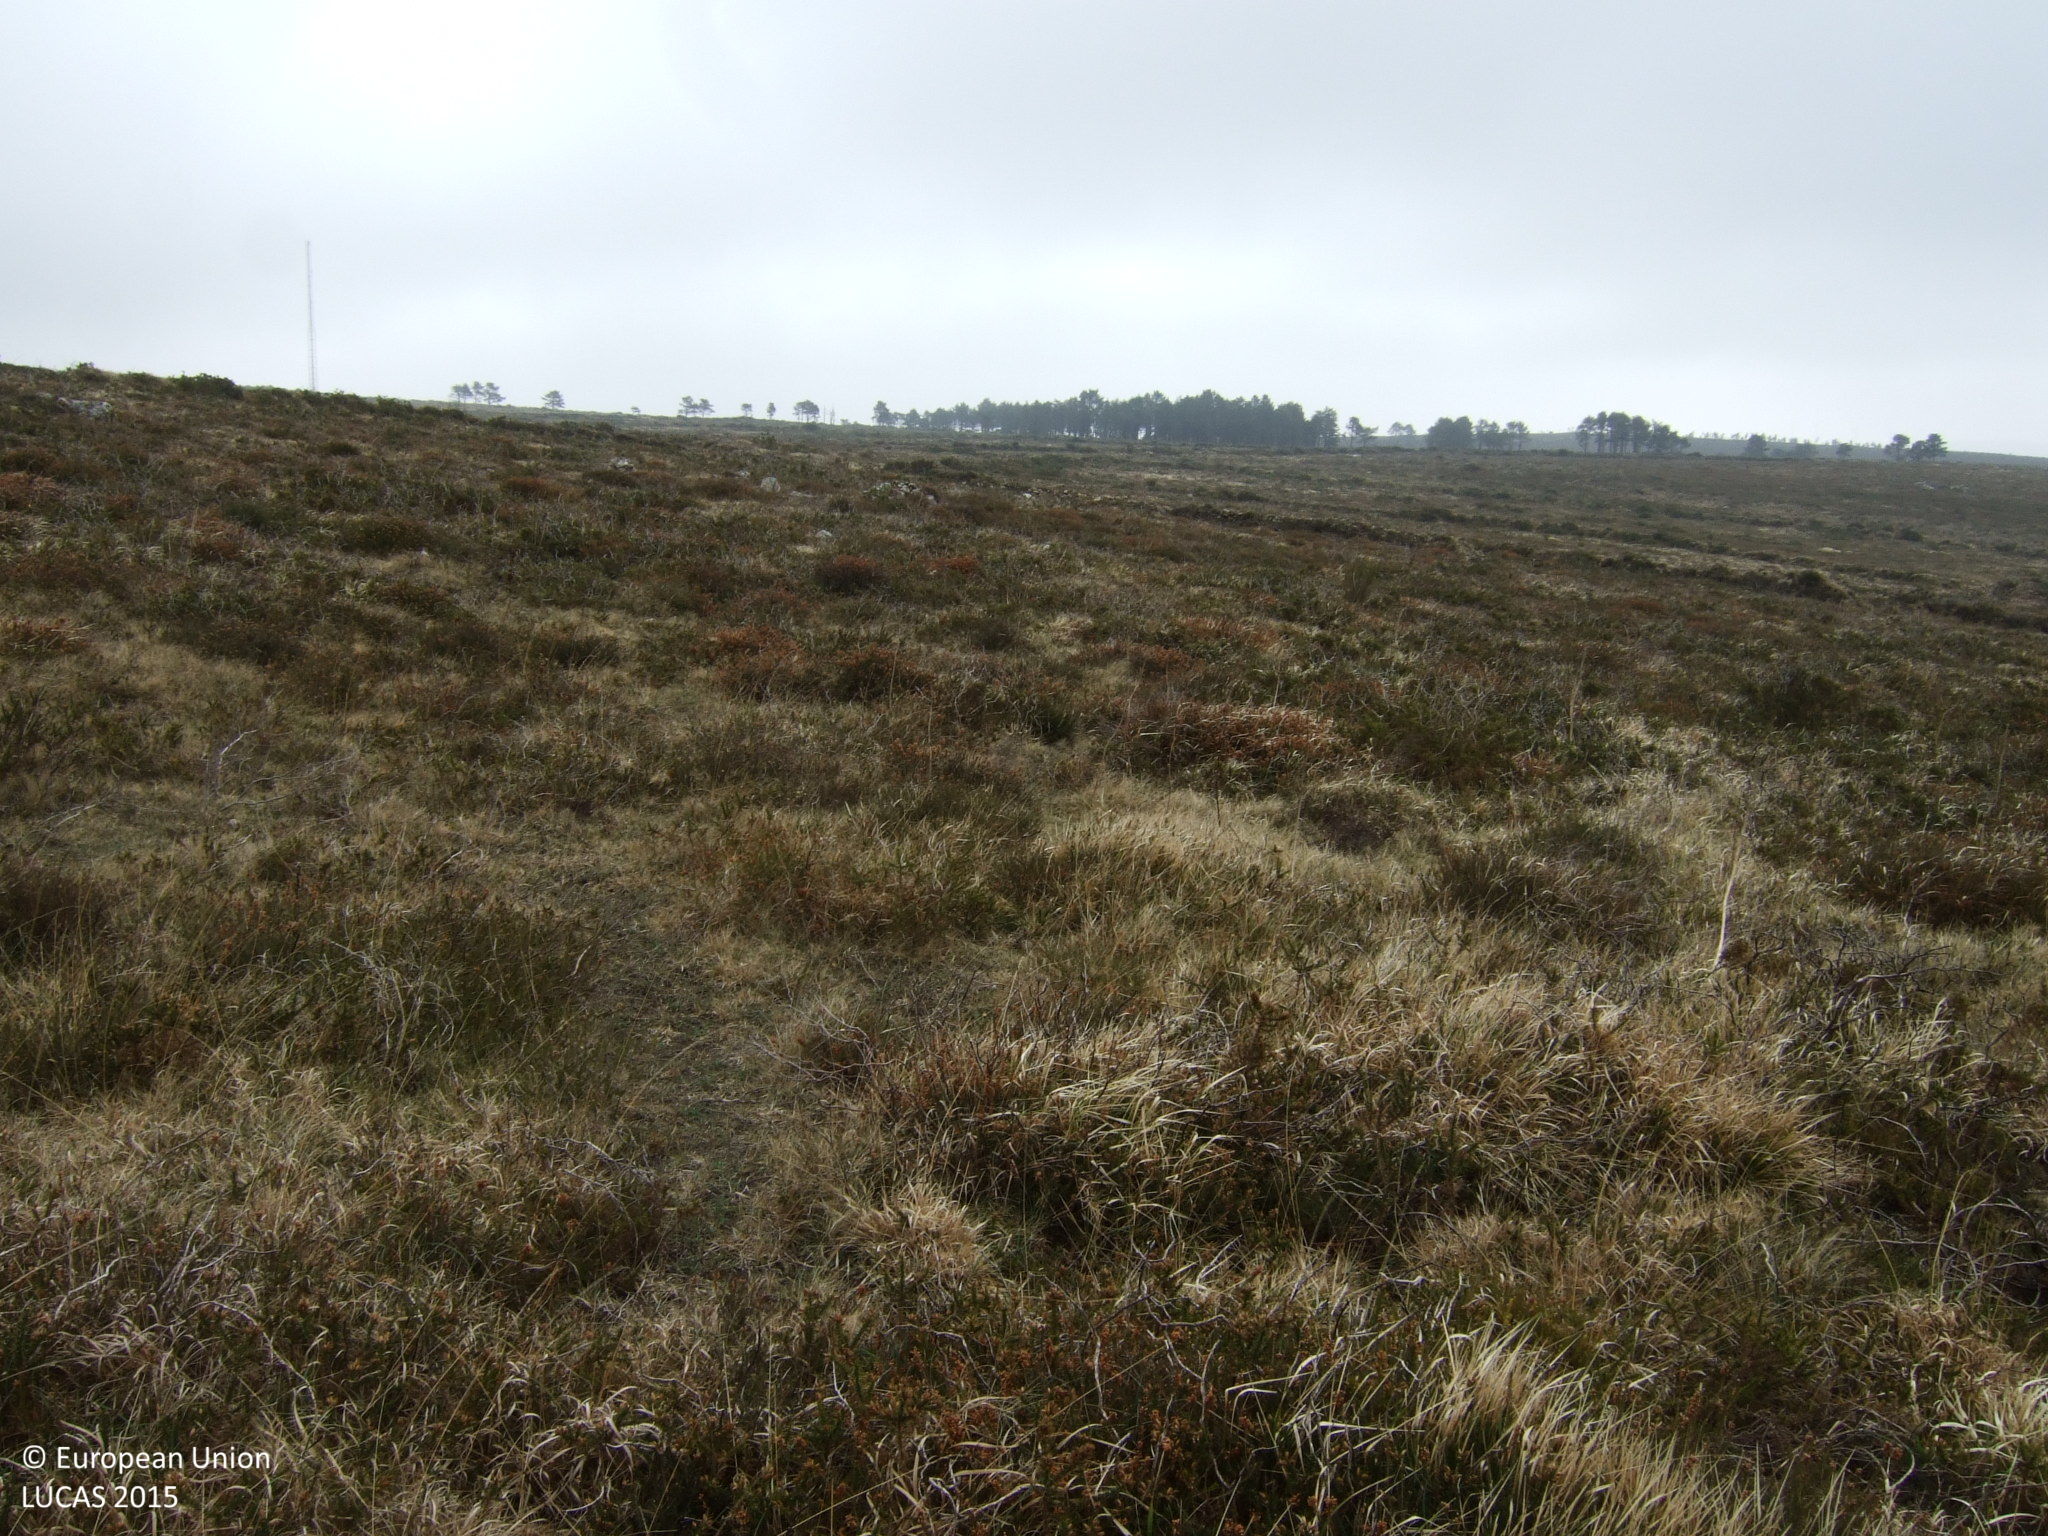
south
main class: Grassland
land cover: Grassland without tree/shrub cover
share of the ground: > 75 %
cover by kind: herbaceous plants 95 %, shrubs 5 %
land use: Agriculture (excluding fallow land and kitchen gardens)
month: March
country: ES
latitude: 42.9805
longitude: -7.9047
